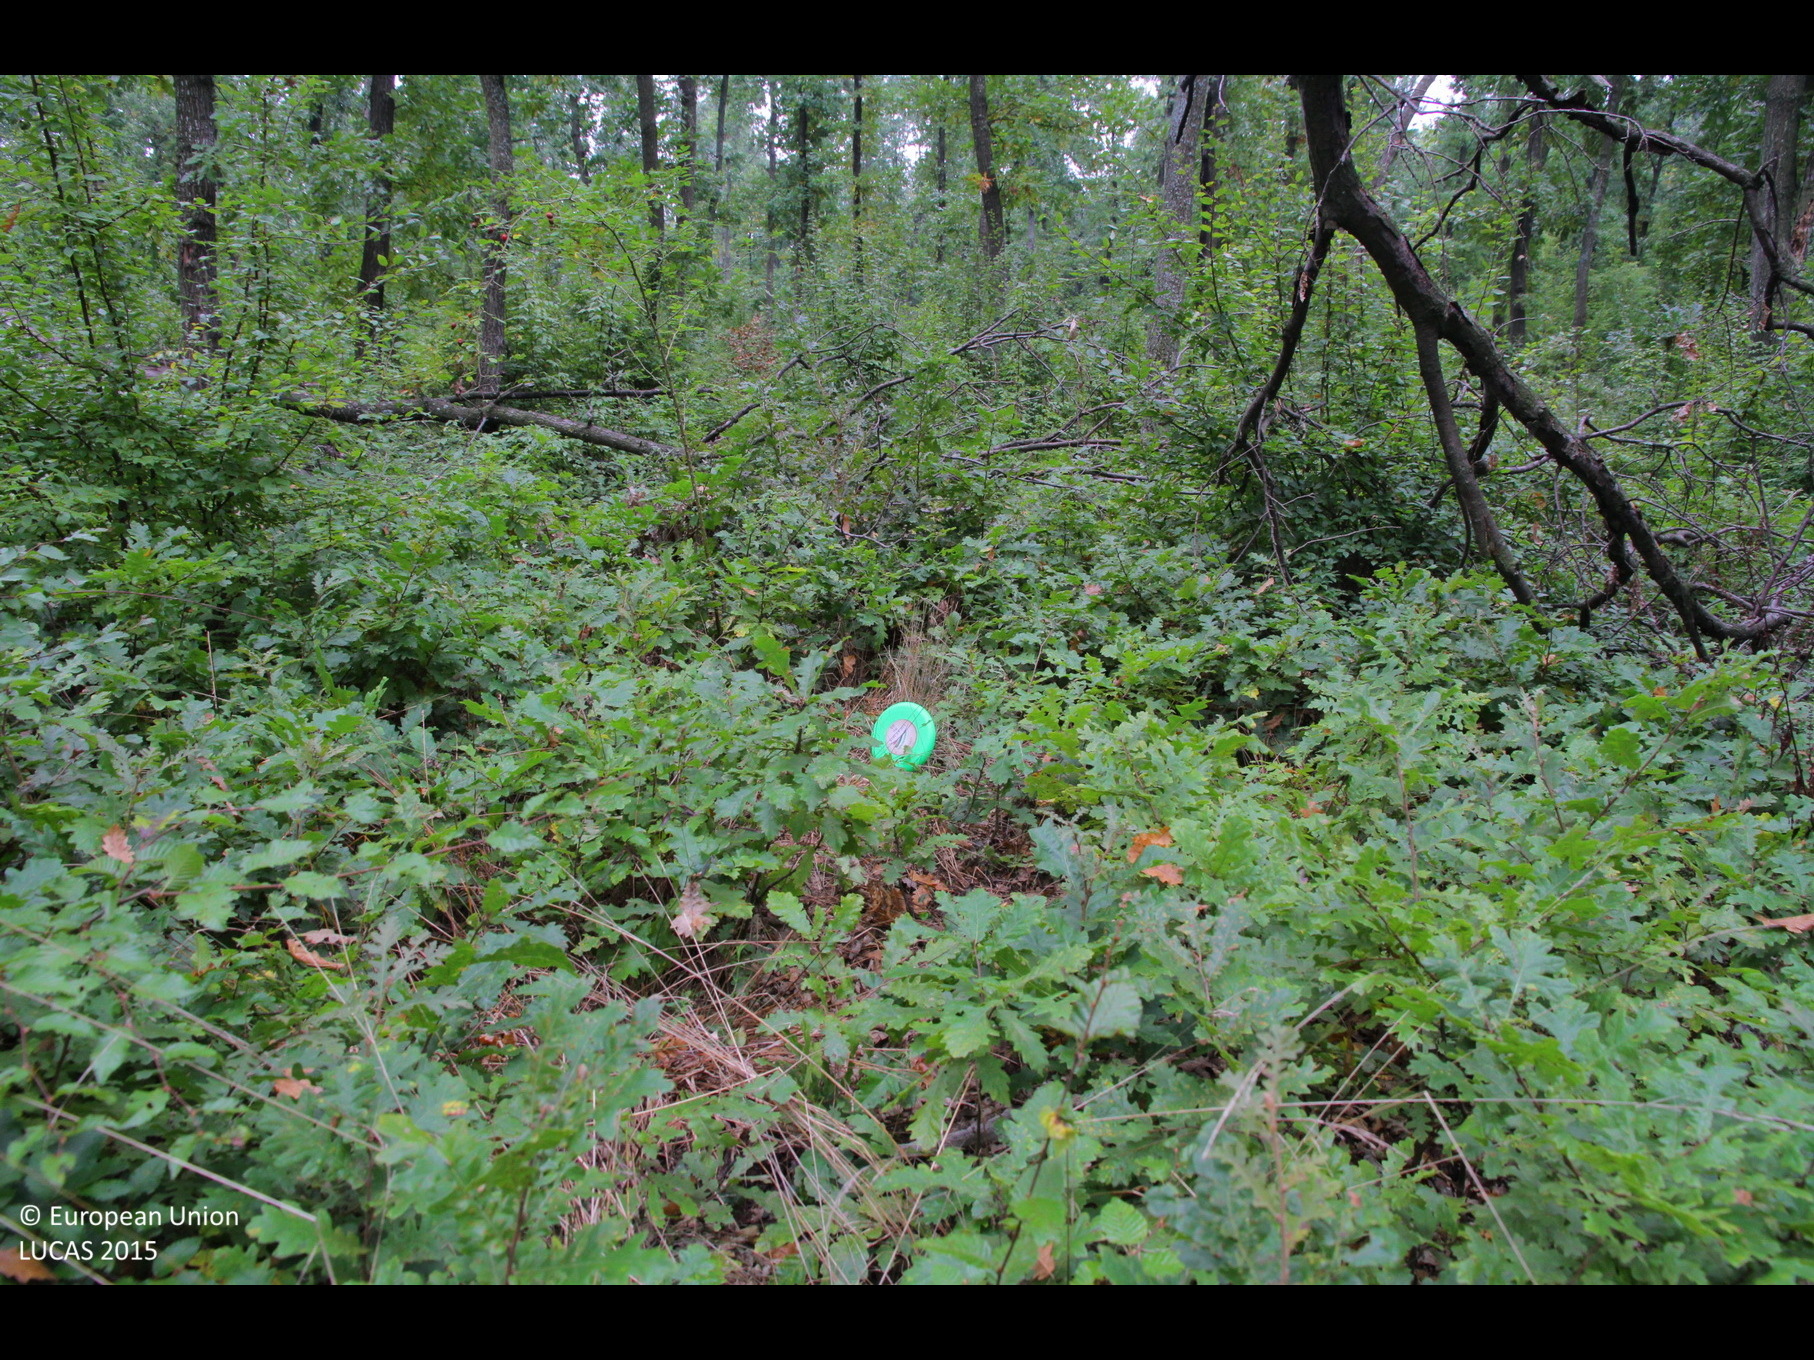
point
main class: Woodland
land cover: Broadleaved woodland
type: mesophytic deciduous forest
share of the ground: > 75 %
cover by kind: broadleaved forest trees 95 %, shrubs 5 %
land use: Forestry
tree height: > 5 m
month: October
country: BG
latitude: 43.5150
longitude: 27.0543
